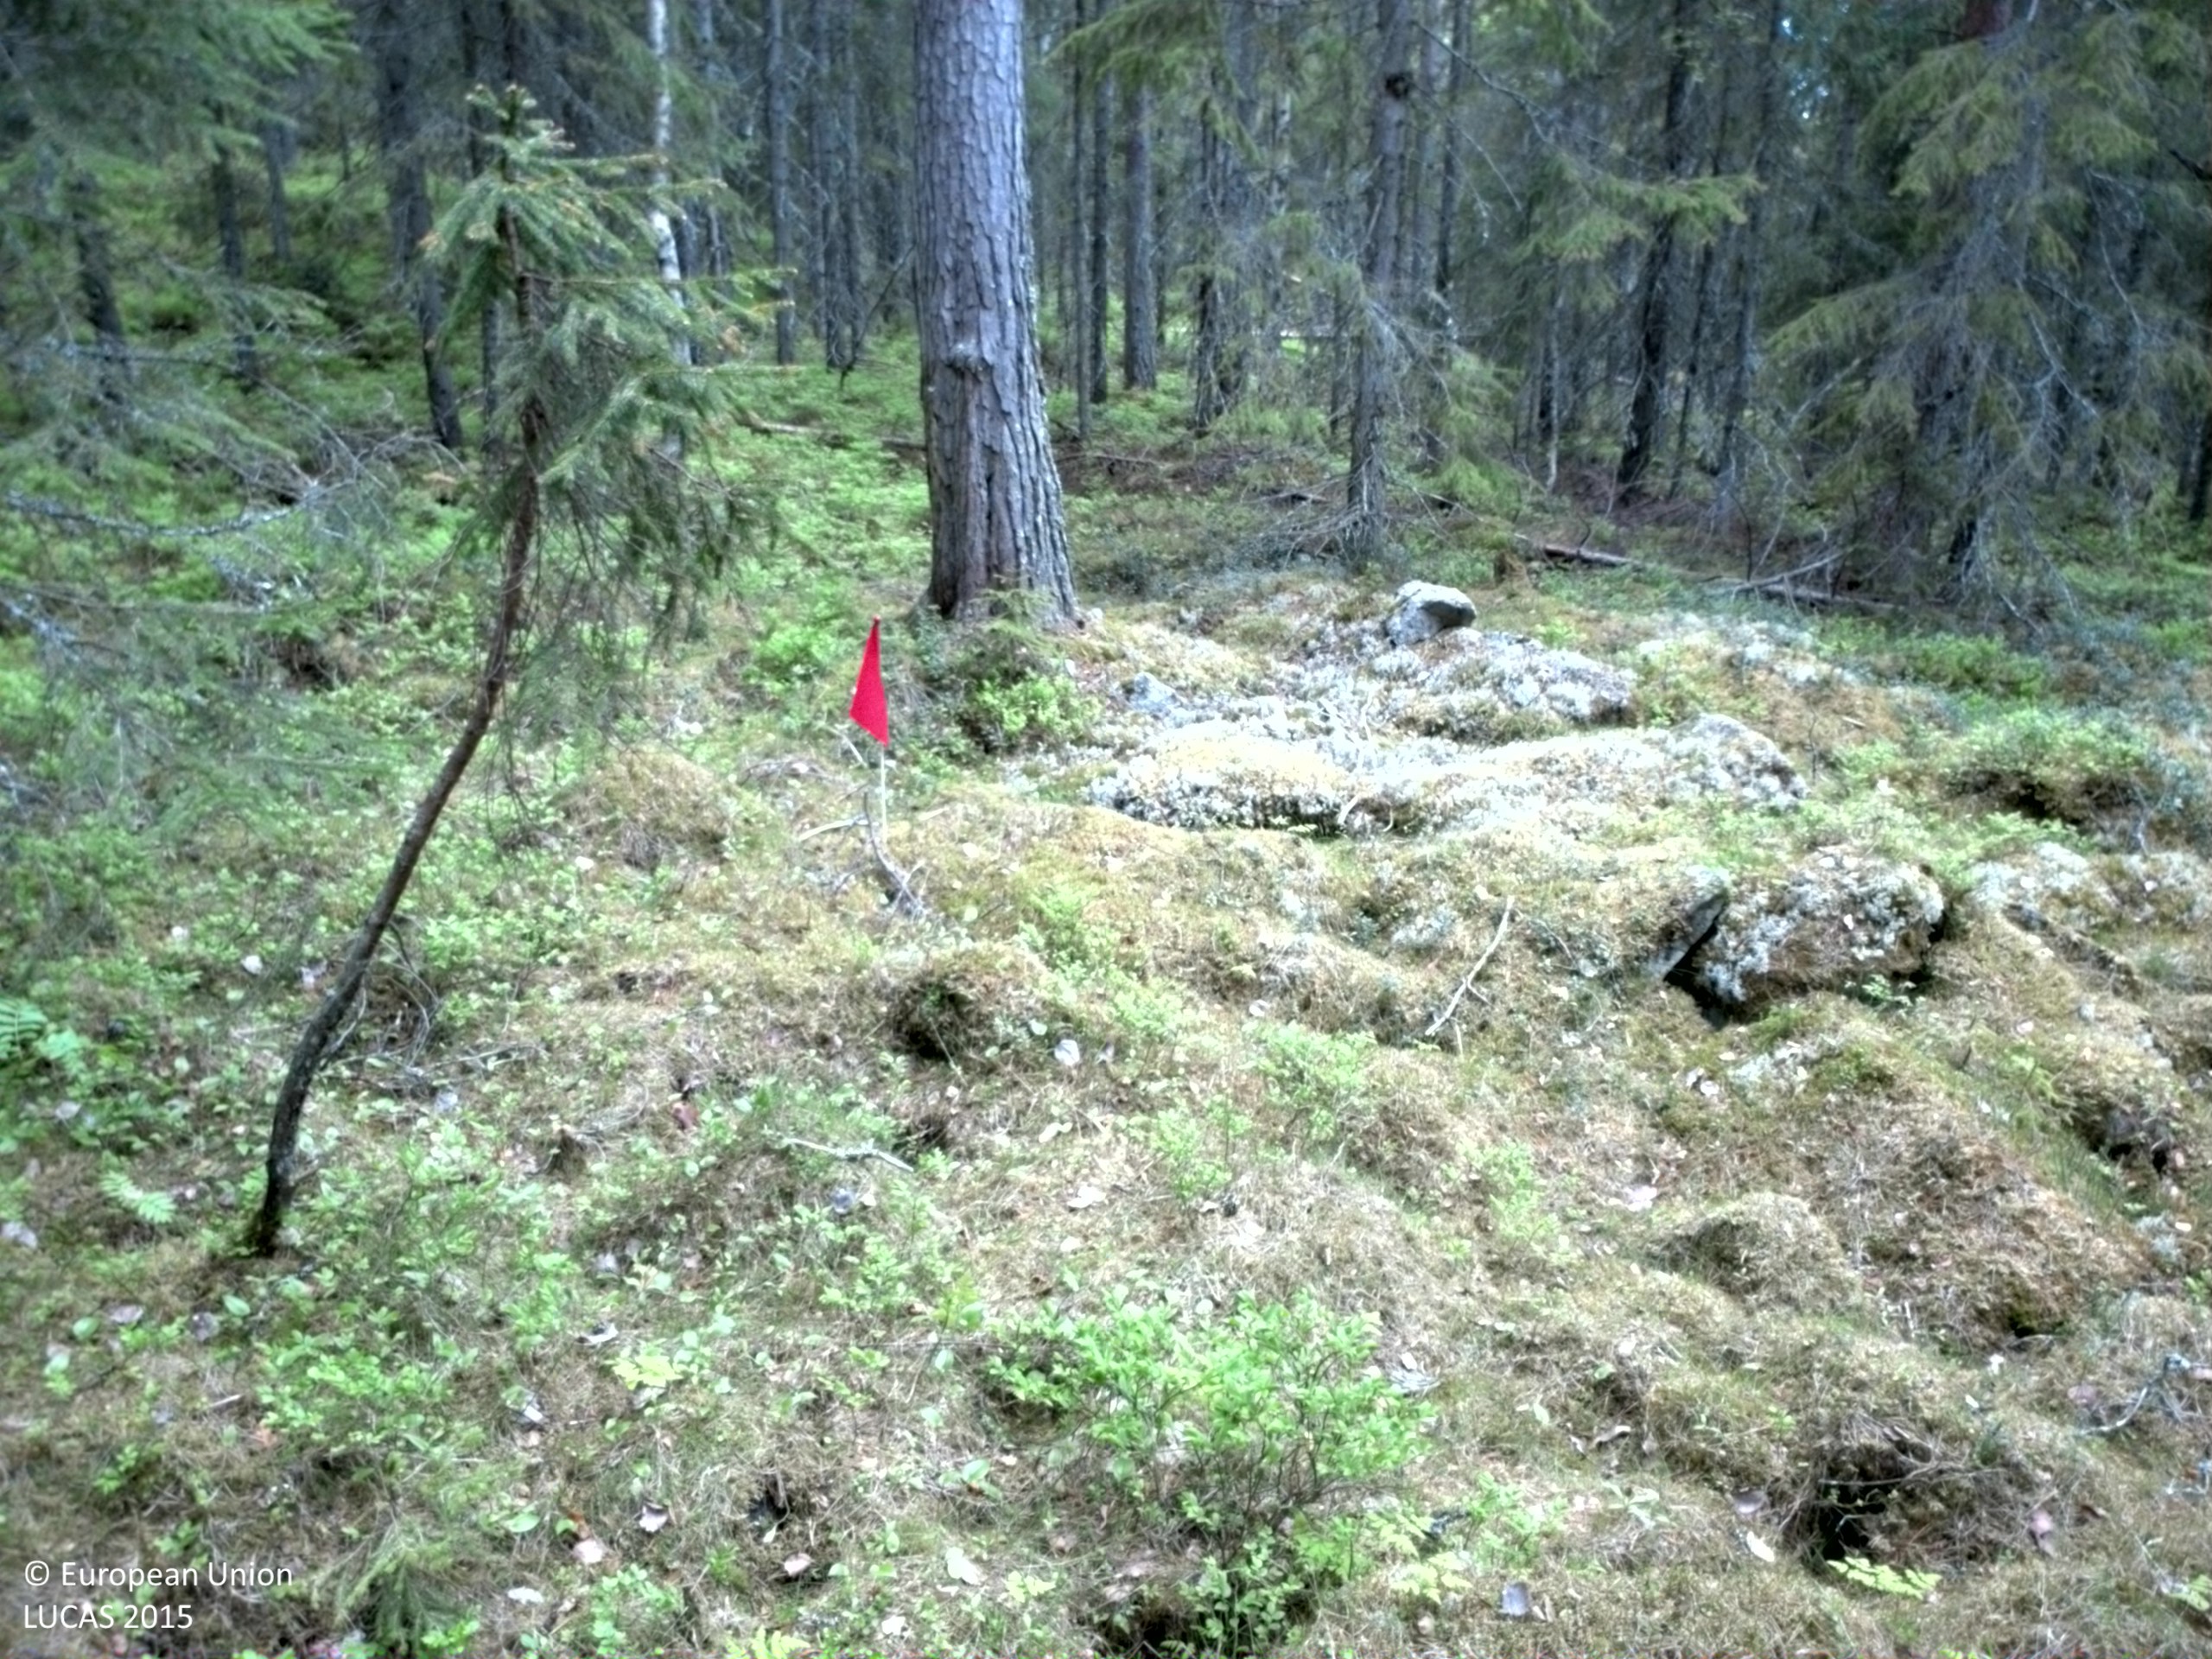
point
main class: Woodland
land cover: Spruce dominated coniferous woodland
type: boreal forest
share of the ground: 50 - 75 %
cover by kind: coniferous forest trees 60 %, shrubs 20 %, lichens and mosses 20 %
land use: Forestry
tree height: > 5 m
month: June
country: SE
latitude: 63.0921
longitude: 17.2054
